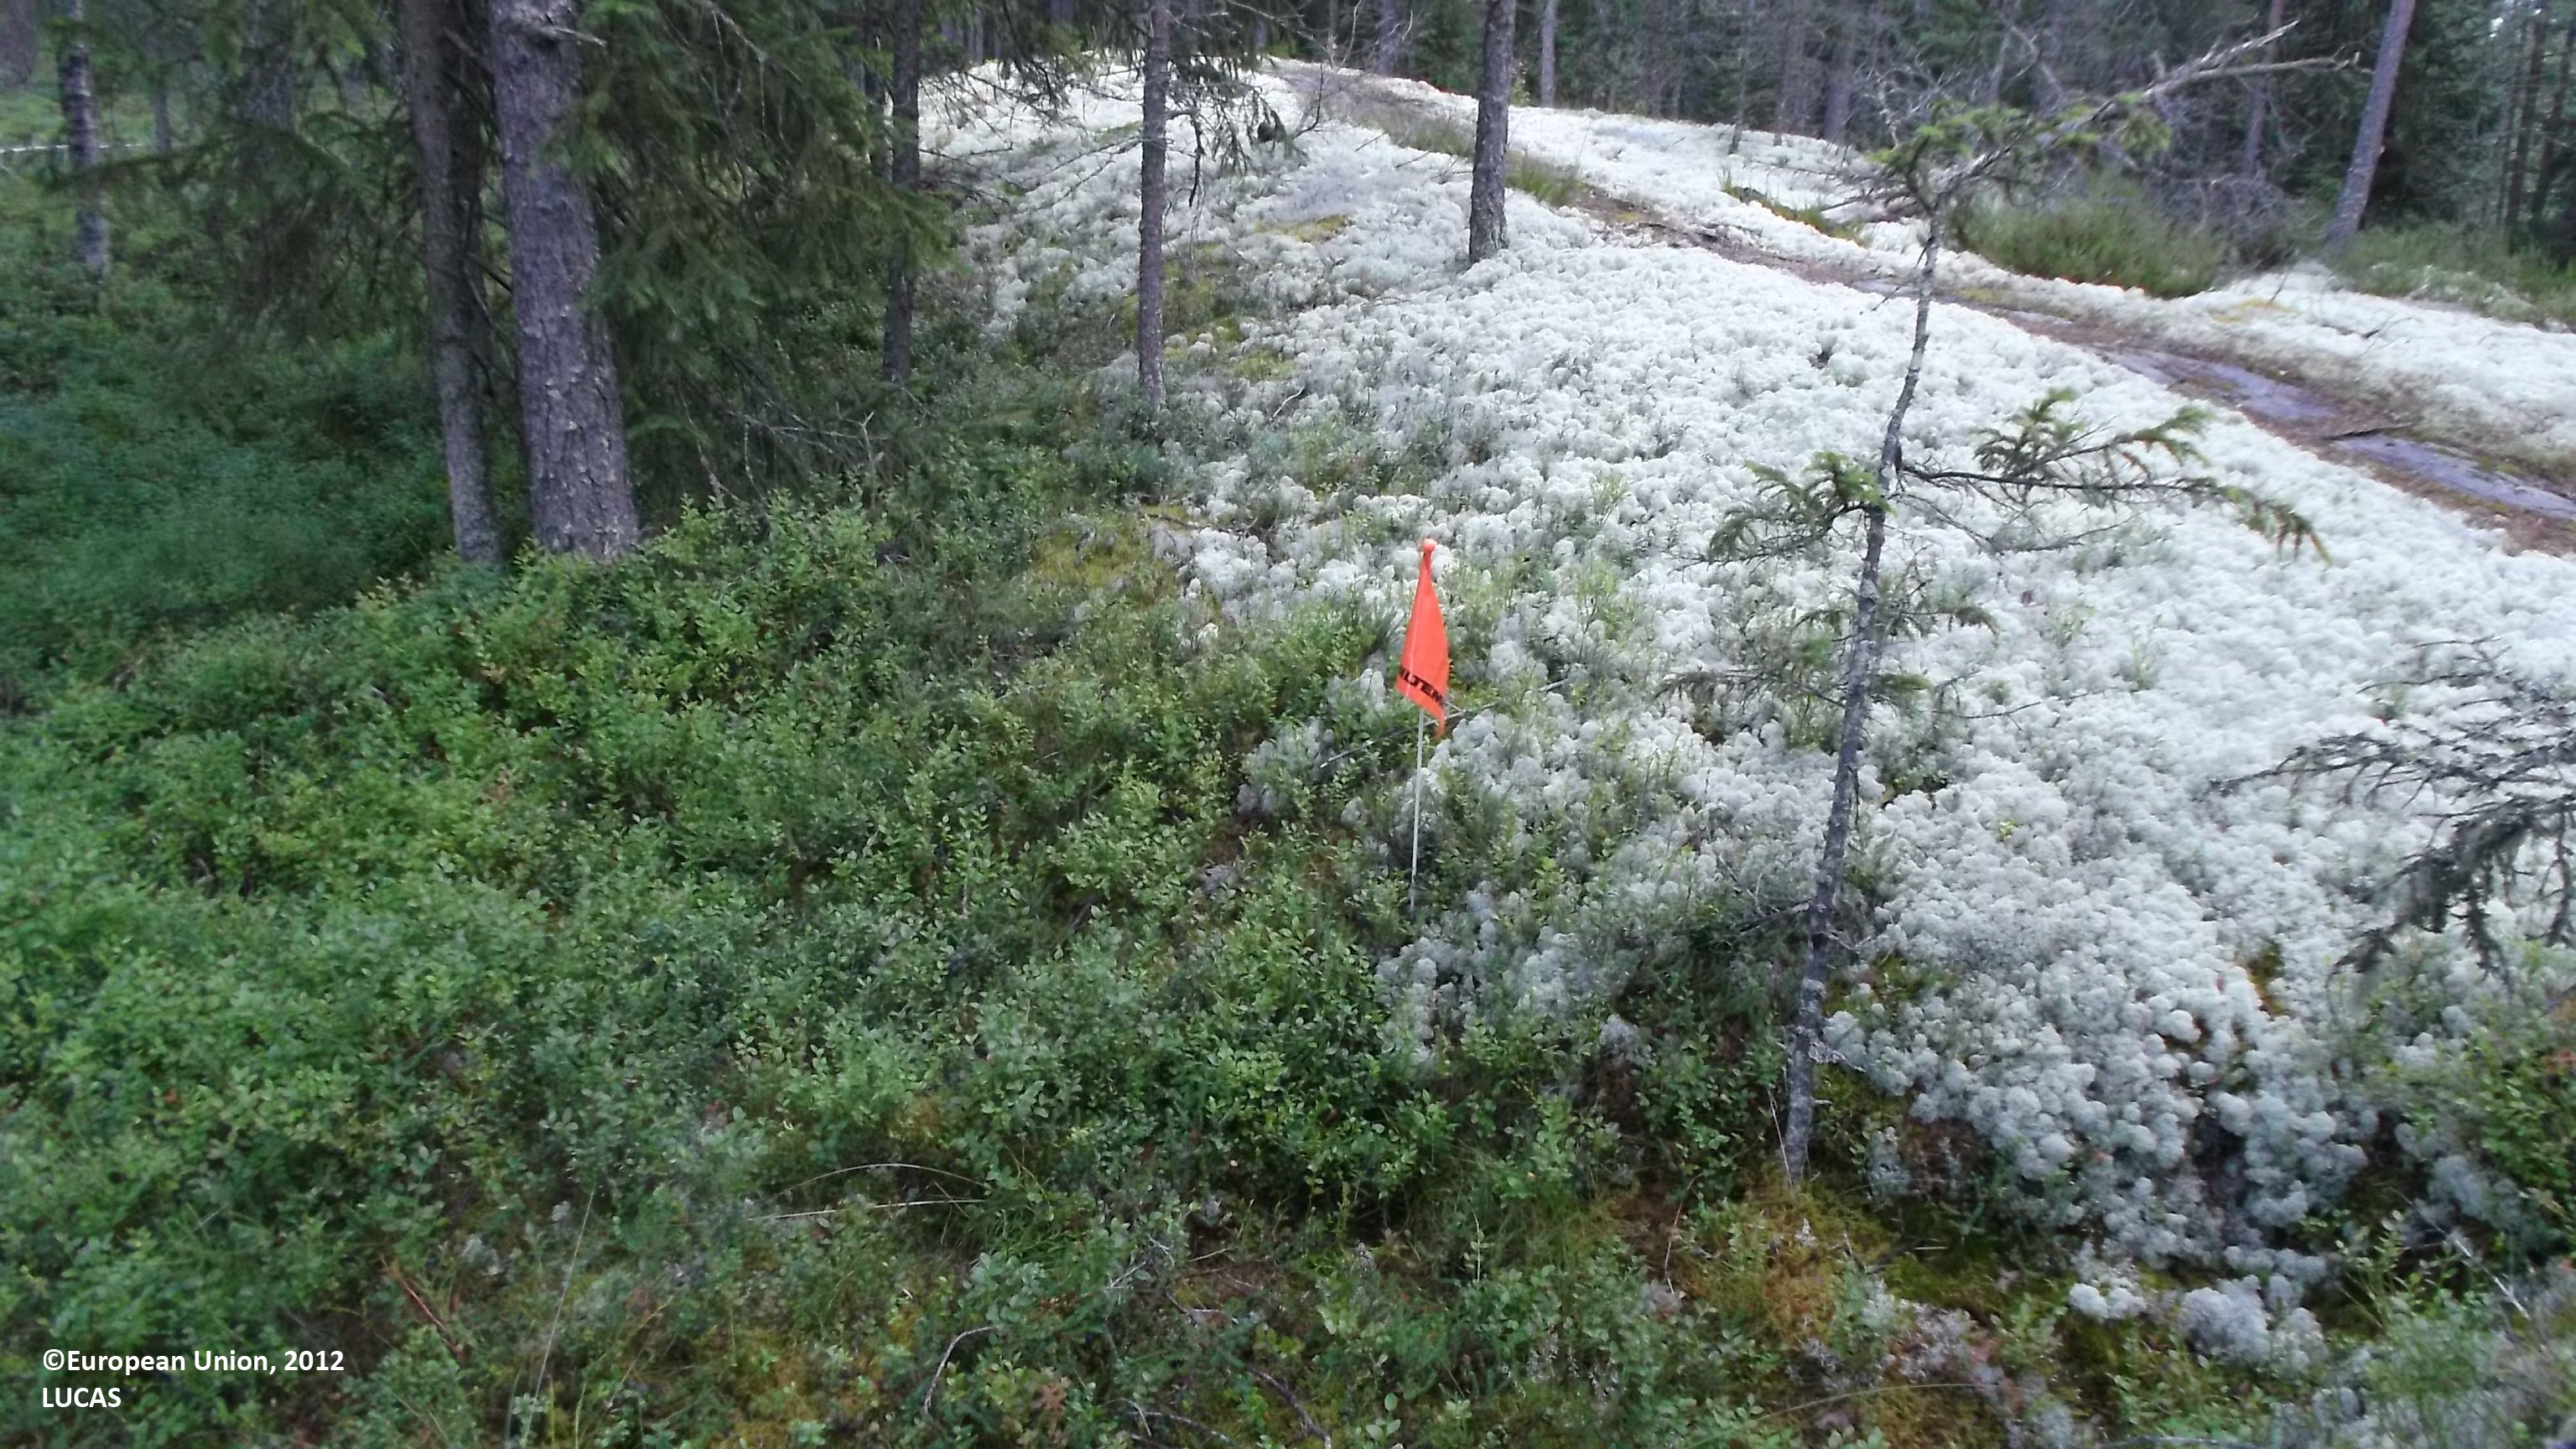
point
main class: Woodland
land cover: Pine dominated mixed woodland
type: boreal forest
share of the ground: 25 - 50 %
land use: Forestry
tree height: > 5 m
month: August
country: FI
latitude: 64.0168
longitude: 23.5393
